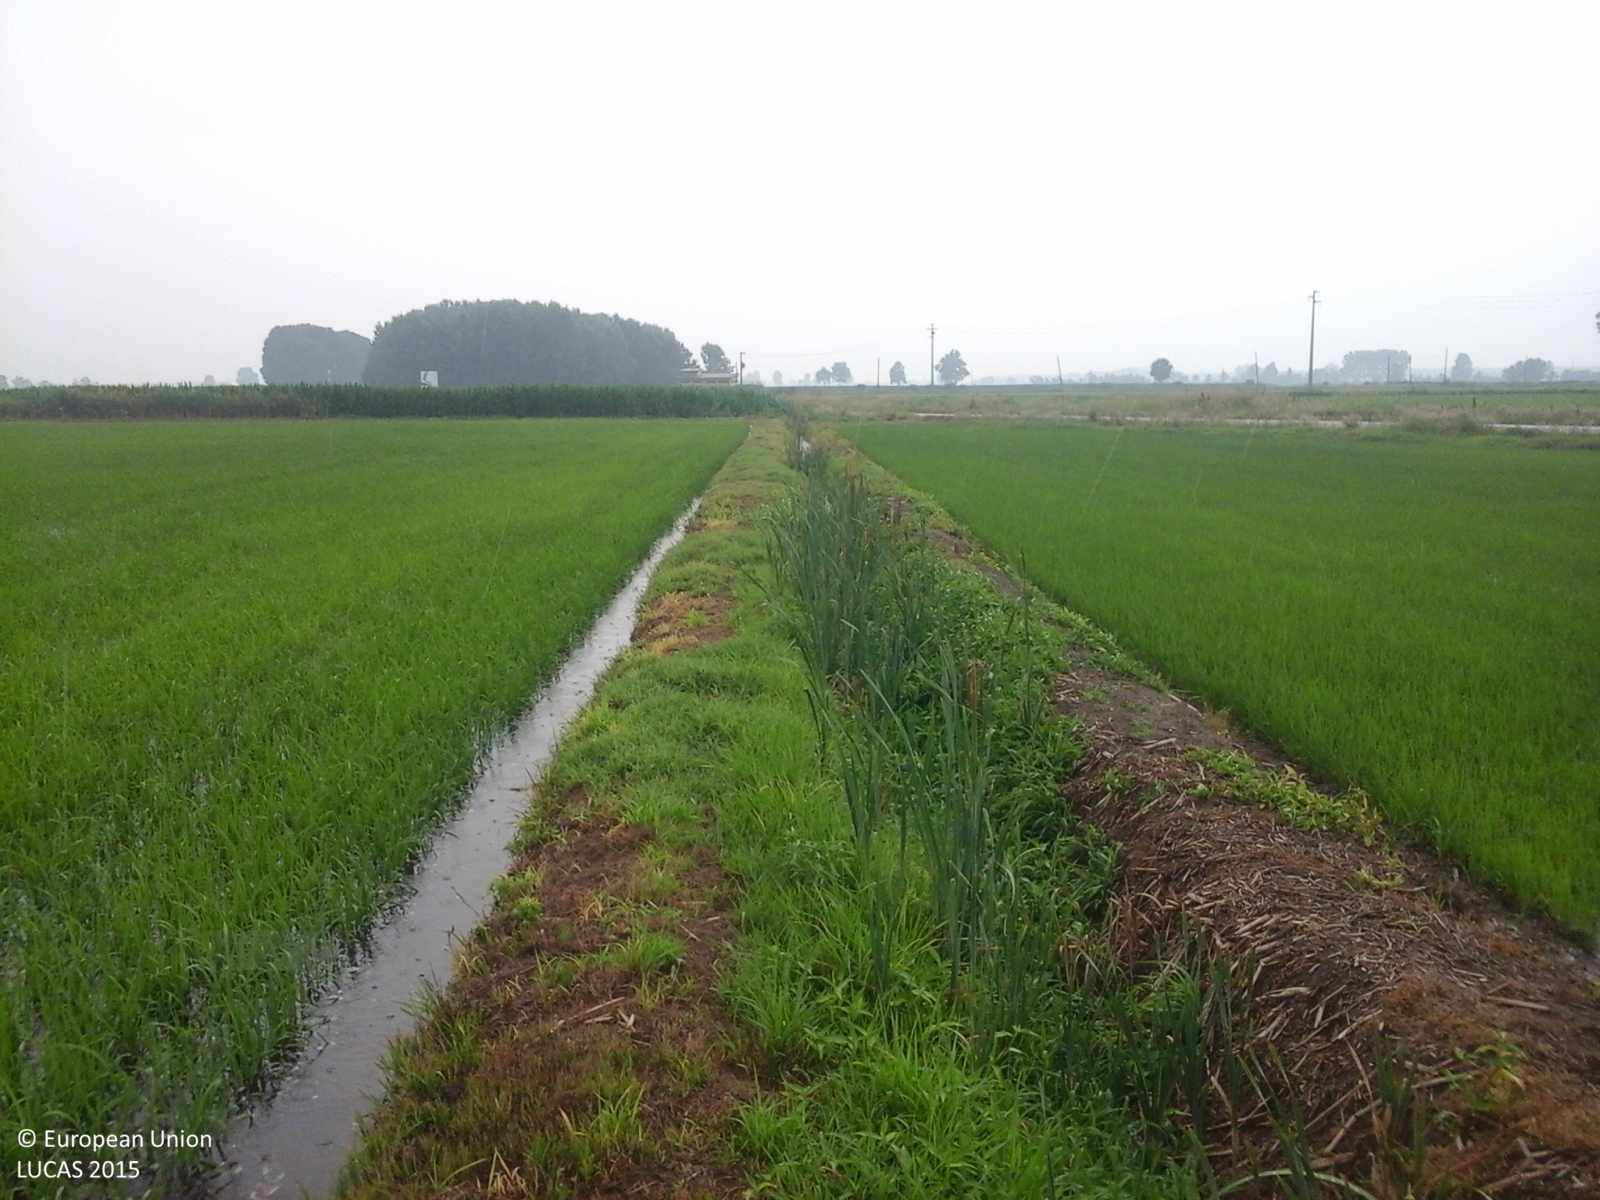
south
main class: Cropland
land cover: Rice
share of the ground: > 75 %
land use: Agriculture (excluding fallow land and kitchen gardens)
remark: Temporary flooded
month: June
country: IT
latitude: 45.1550
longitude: 8.7938
